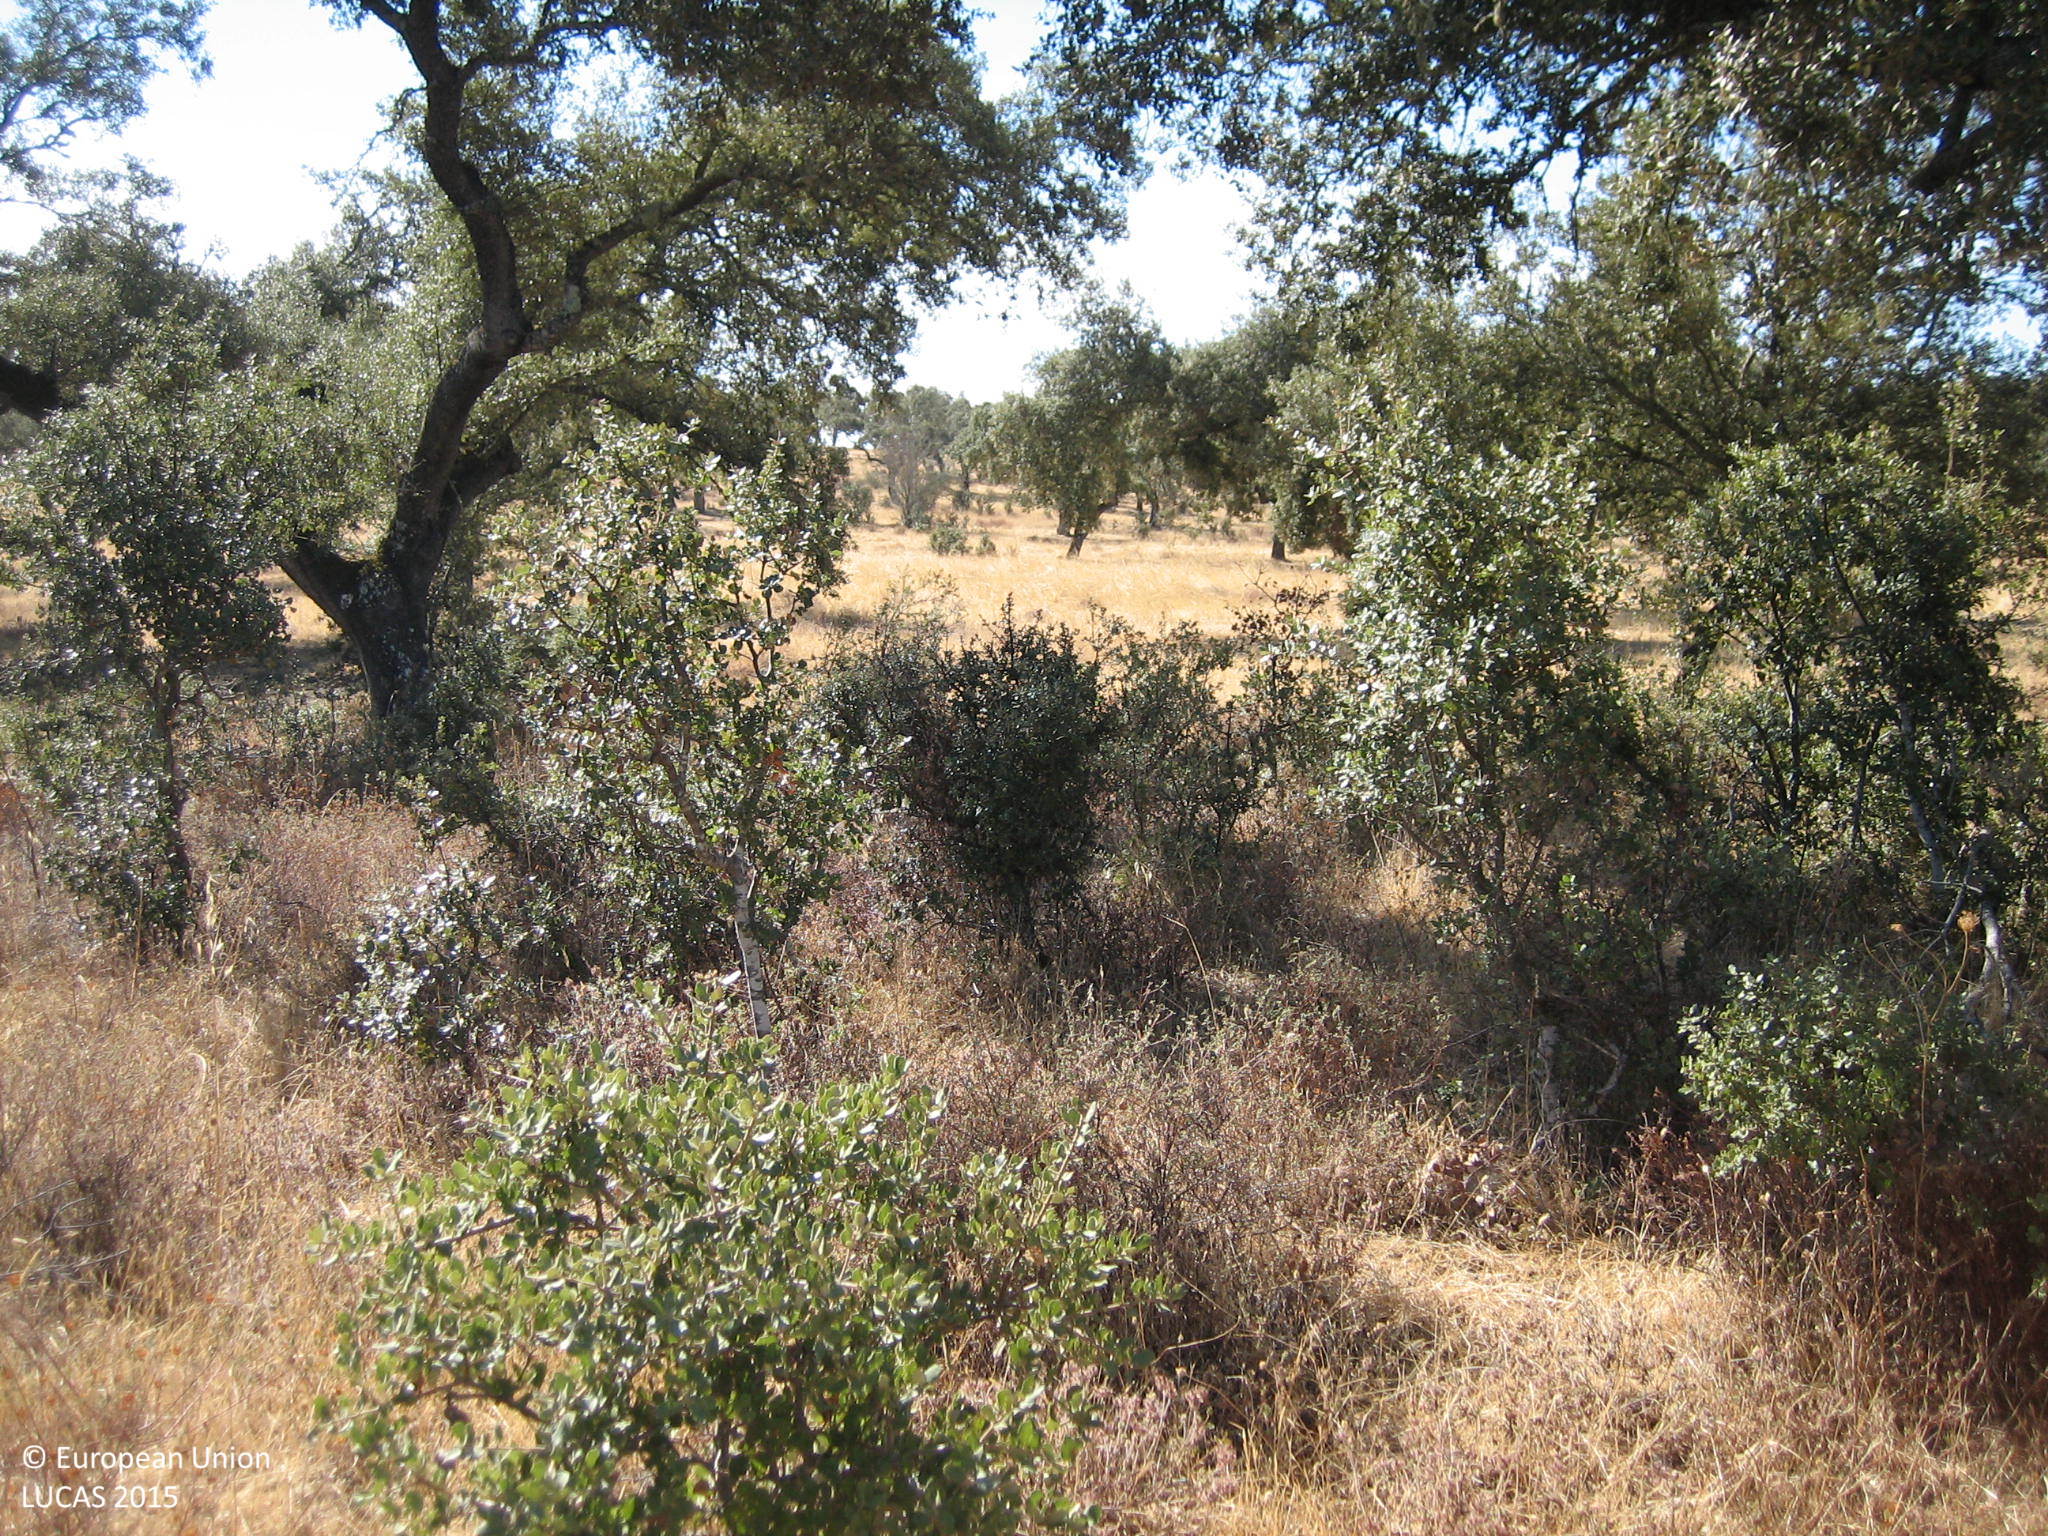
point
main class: Woodland
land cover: Broadleaved woodland
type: broadleaved evergreen forest
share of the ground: 10 - 25 %
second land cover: Shrubland without tree cover
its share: 10 - 25 %
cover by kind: herbaceous plants 40 %, broadleaved forest trees 20 %, shrubs 20 %, unconsolidated bare surface 20 %
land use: Forestry
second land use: Agriculture (excluding fallow land and kitchen gardens)
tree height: > 5 m
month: August
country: ES
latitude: 38.5115
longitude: -7.2132
